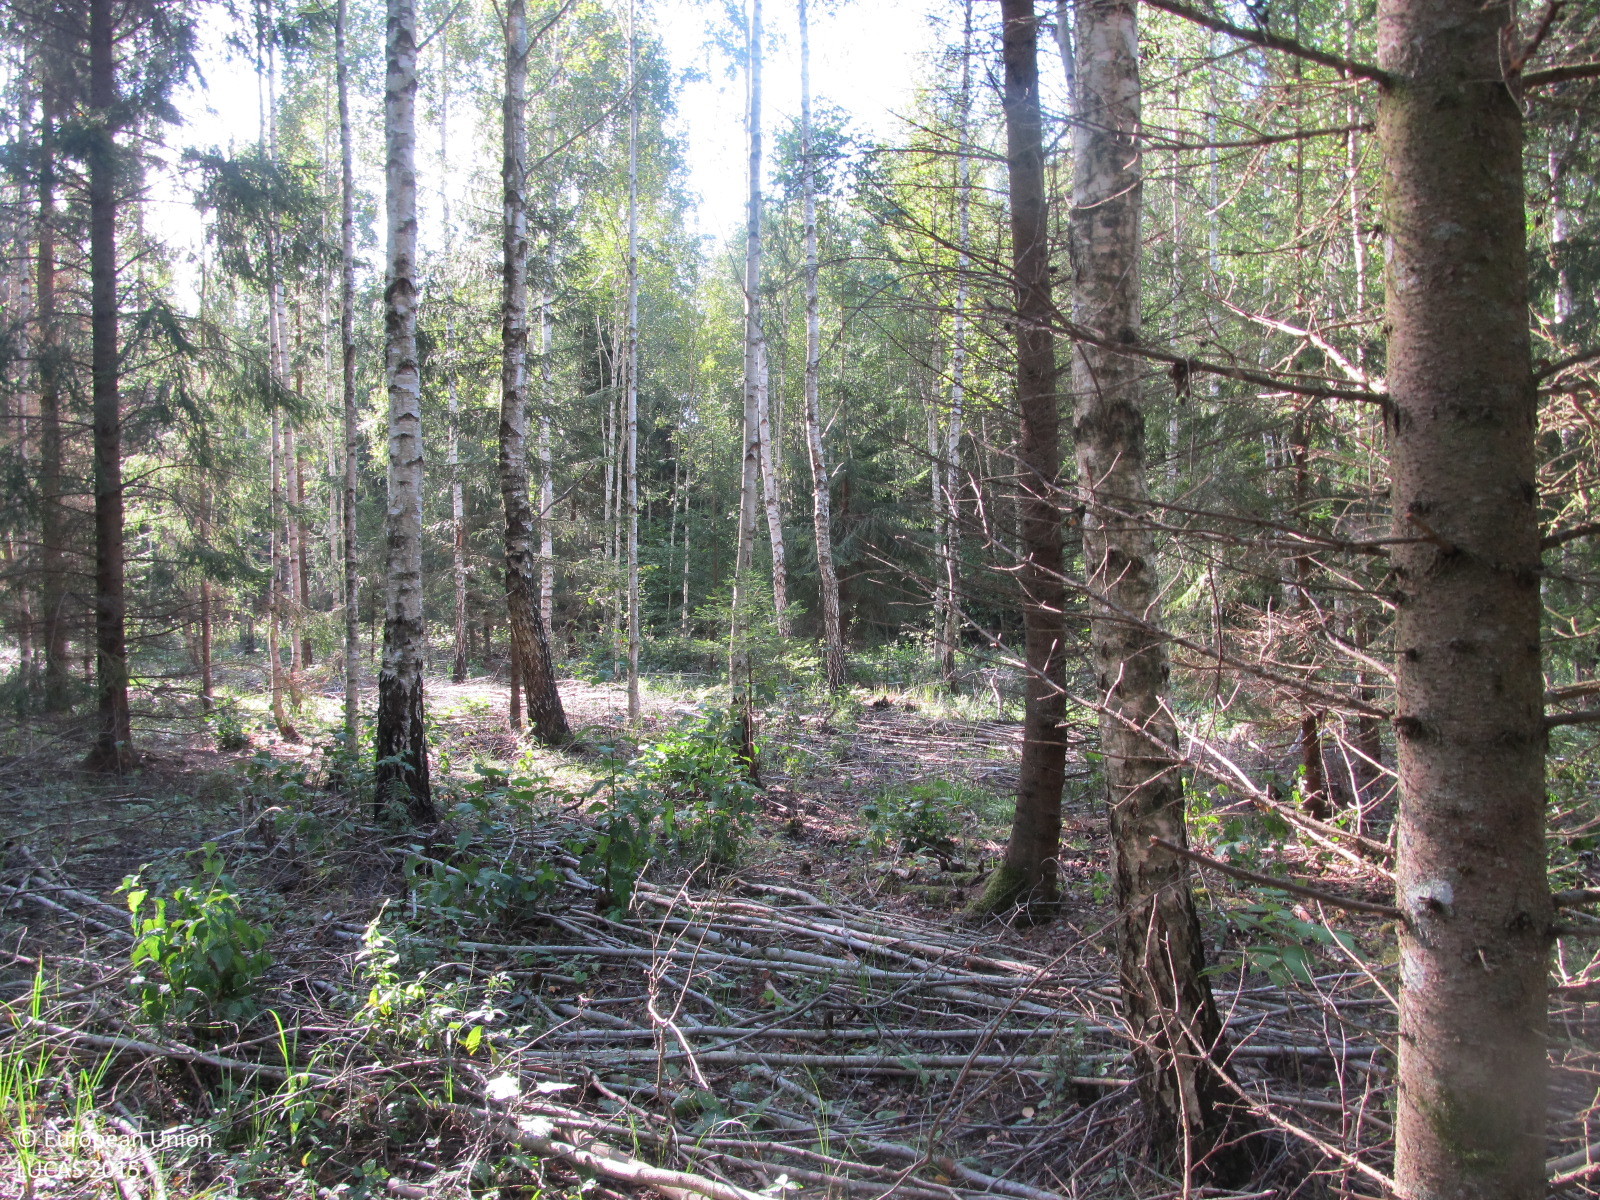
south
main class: Woodland
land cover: Spruce dominated mixed woodland
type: hemiboreal forest and nemoral coniferous forest and mixed broadleaved-coniferous forest
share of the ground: > 75 %
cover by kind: coniferous forest trees 50 %, broadleaved forest trees 30 %, shrubs 10 %, herbaceous plants 5 %, lichens and mosses 5 %
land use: Forestry
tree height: > 5 m
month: September
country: LT
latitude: 56.0978
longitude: 23.4341
